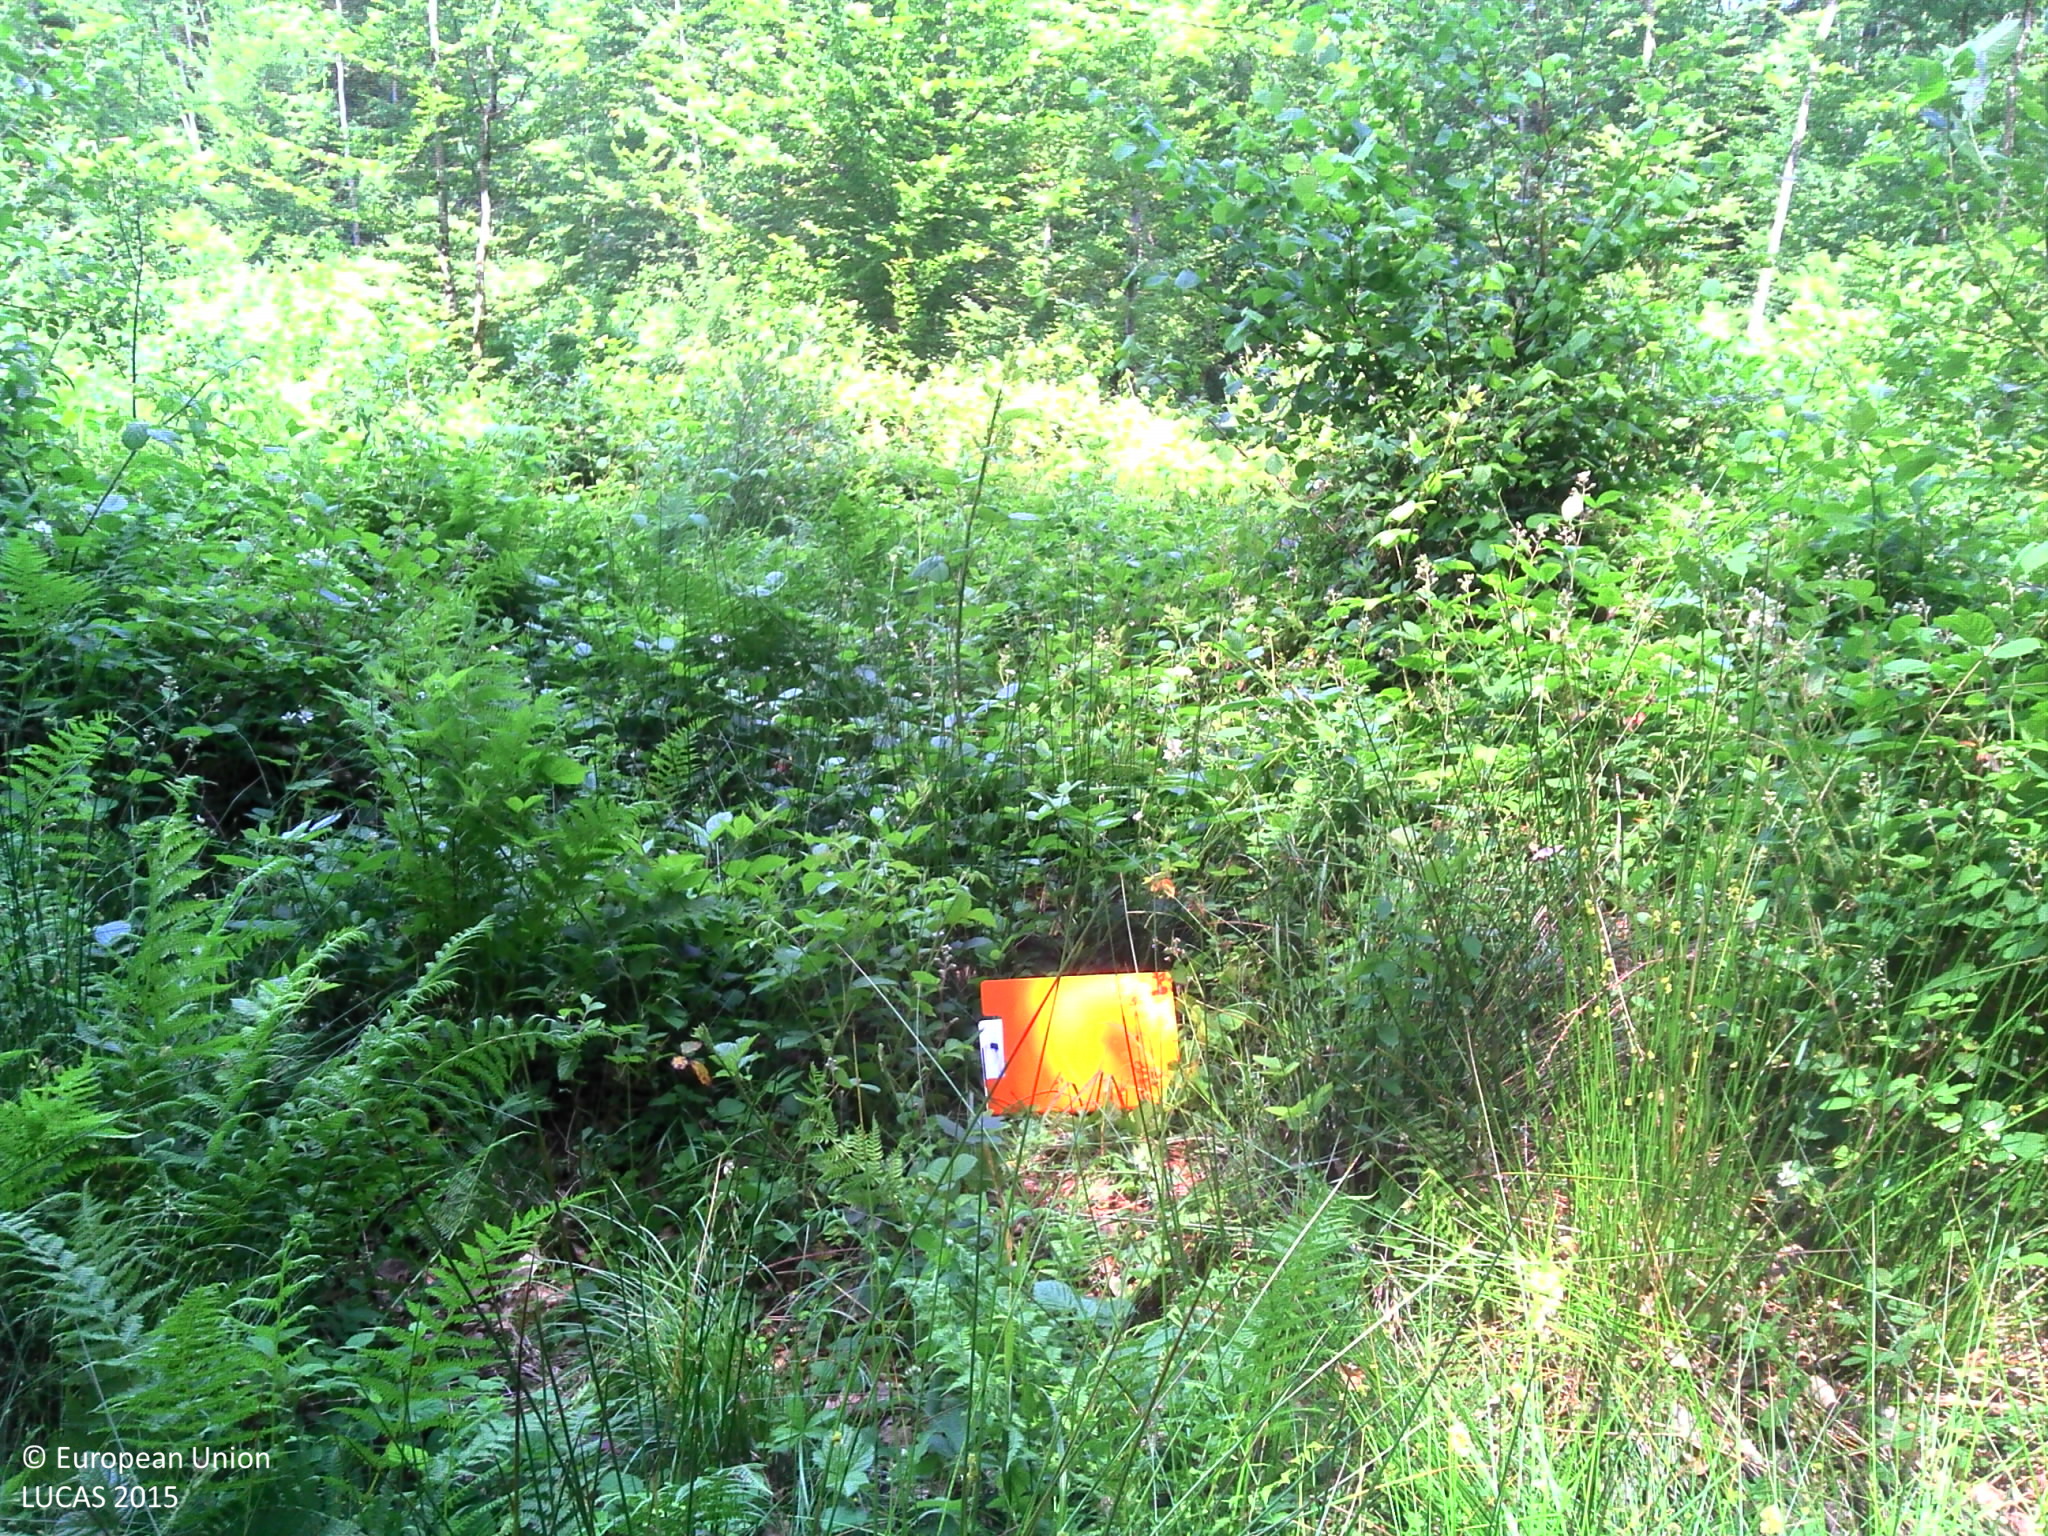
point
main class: Shrubland
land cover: Shrubland without tree cover
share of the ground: > 75 %
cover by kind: shrubs 95 %, herbaceous plants 5 %
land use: Forestry
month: June
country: FR
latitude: 47.8543
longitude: 6.2721
